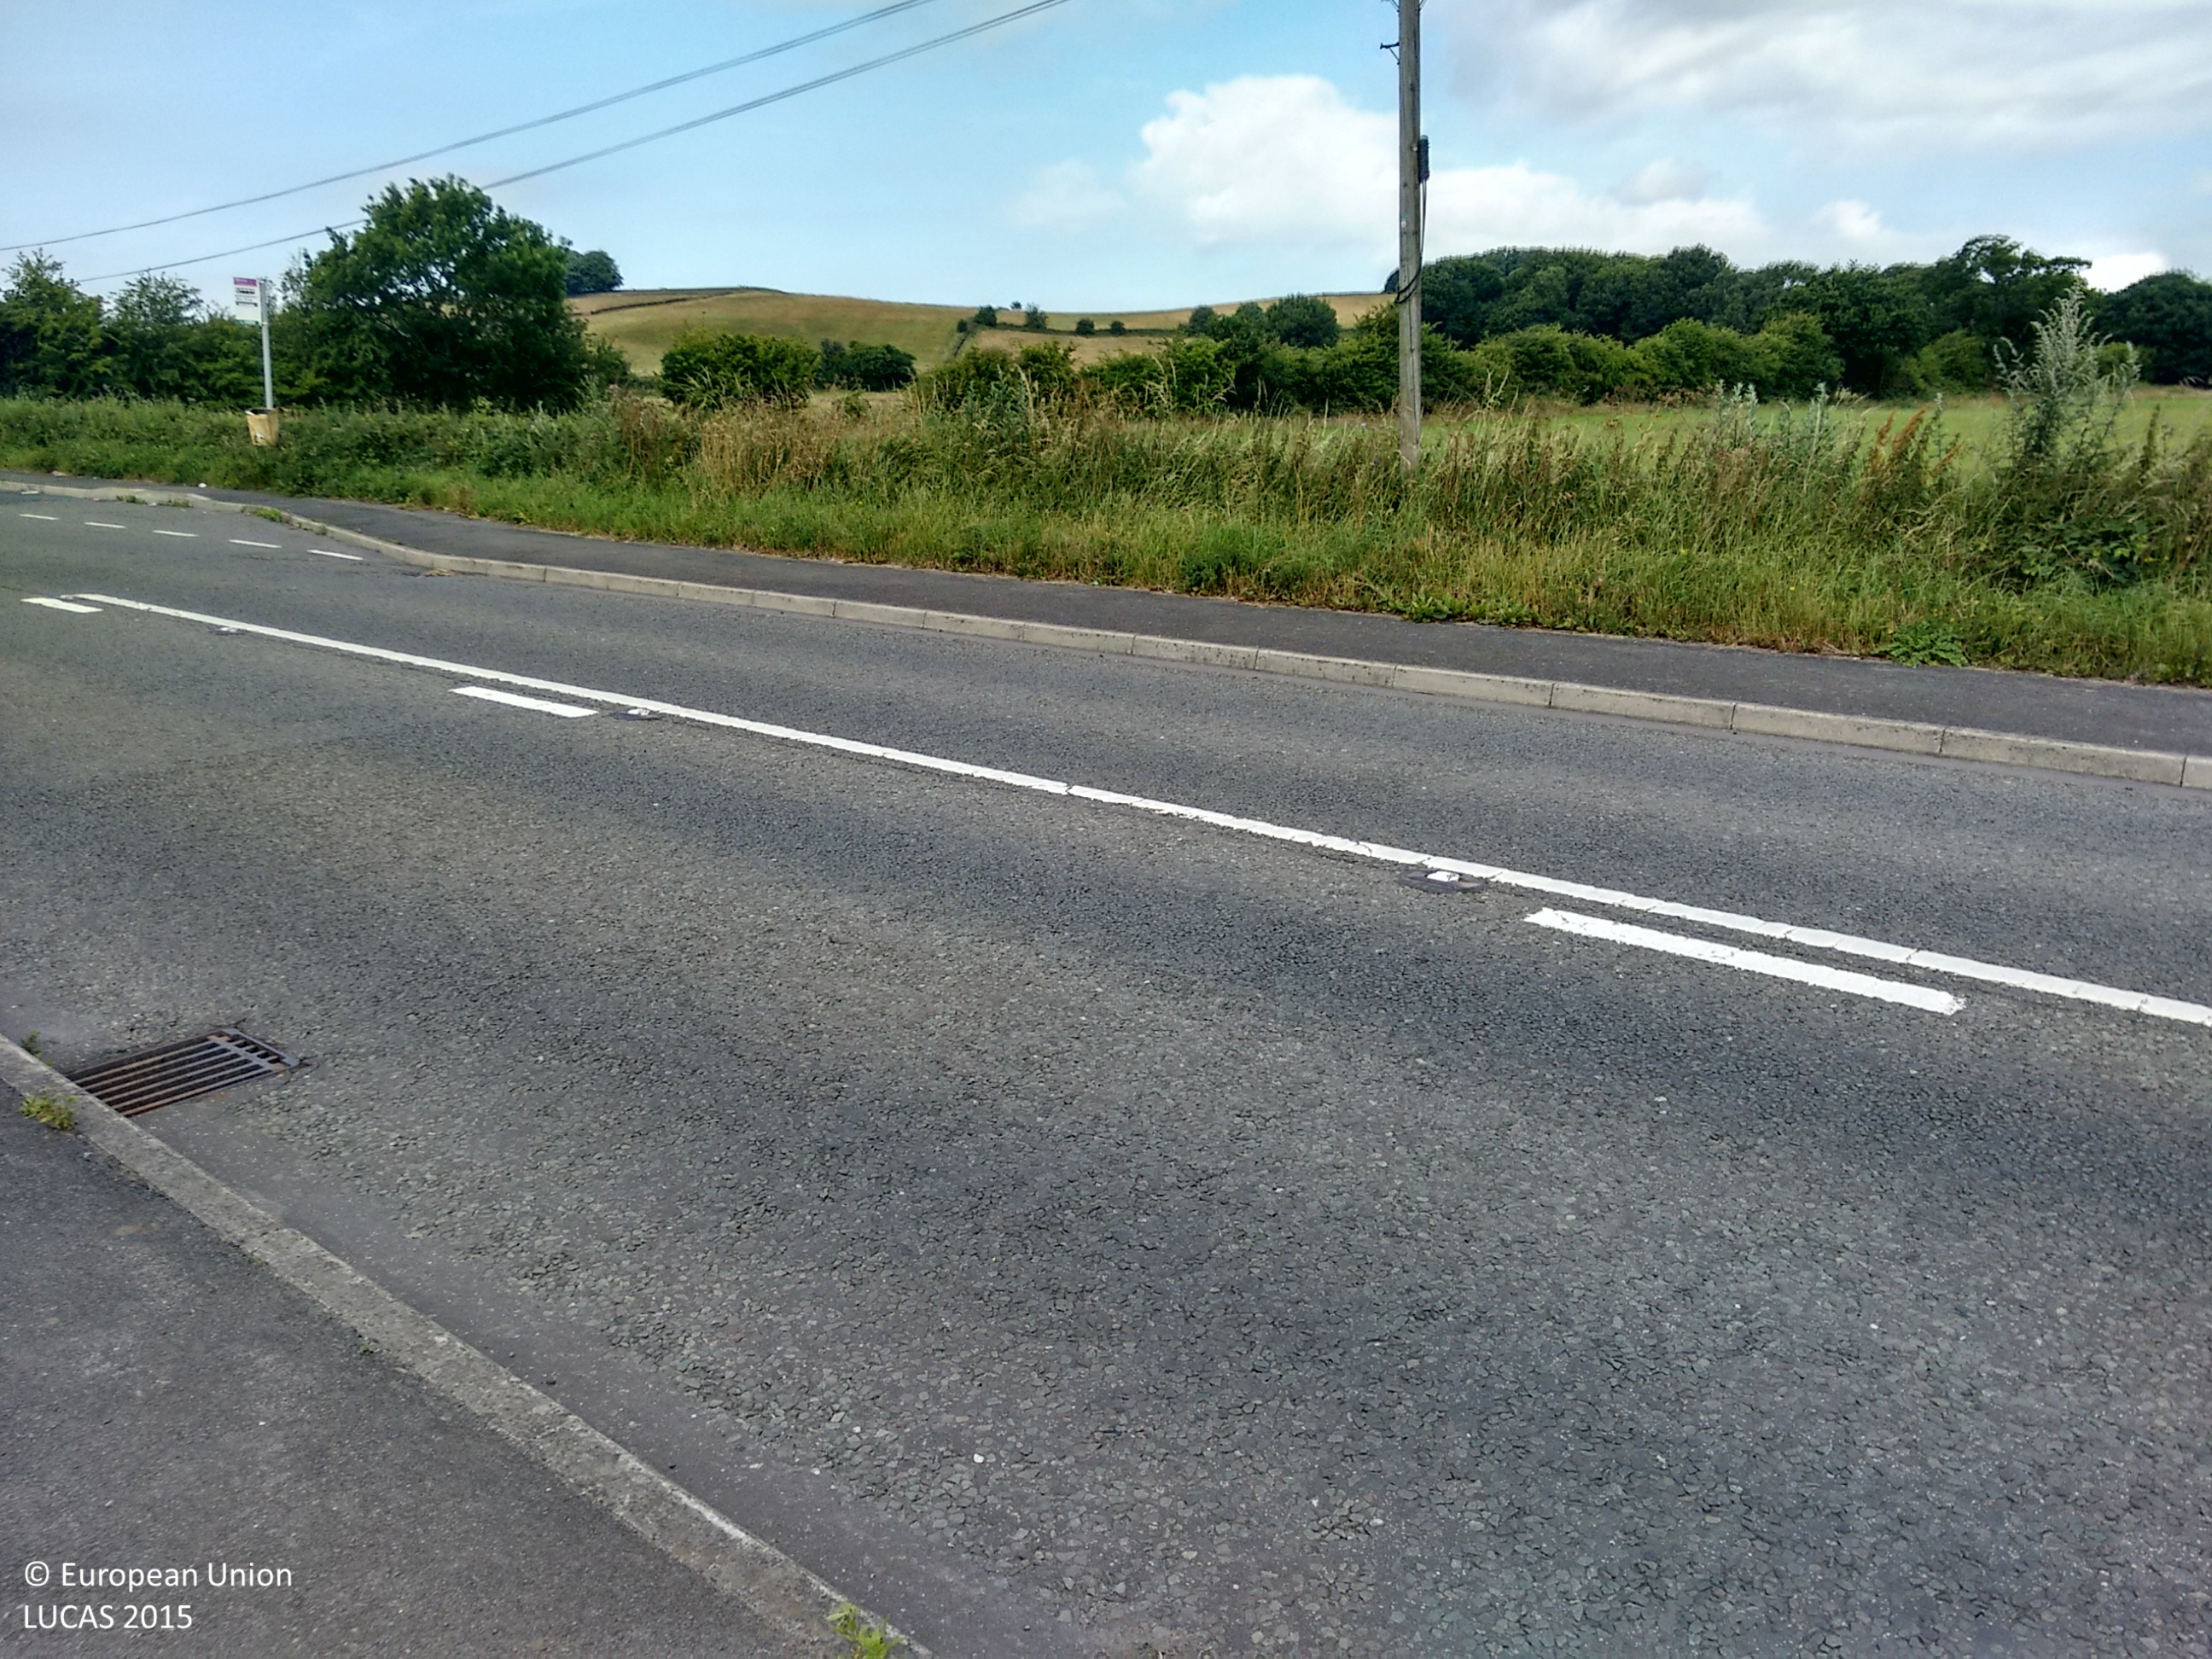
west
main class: Cropland
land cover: Rape and turnip rape
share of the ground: > 75 %
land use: Agriculture (excluding fallow land and kitchen gardens)
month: July
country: GB
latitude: 53.0376
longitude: -1.4588
